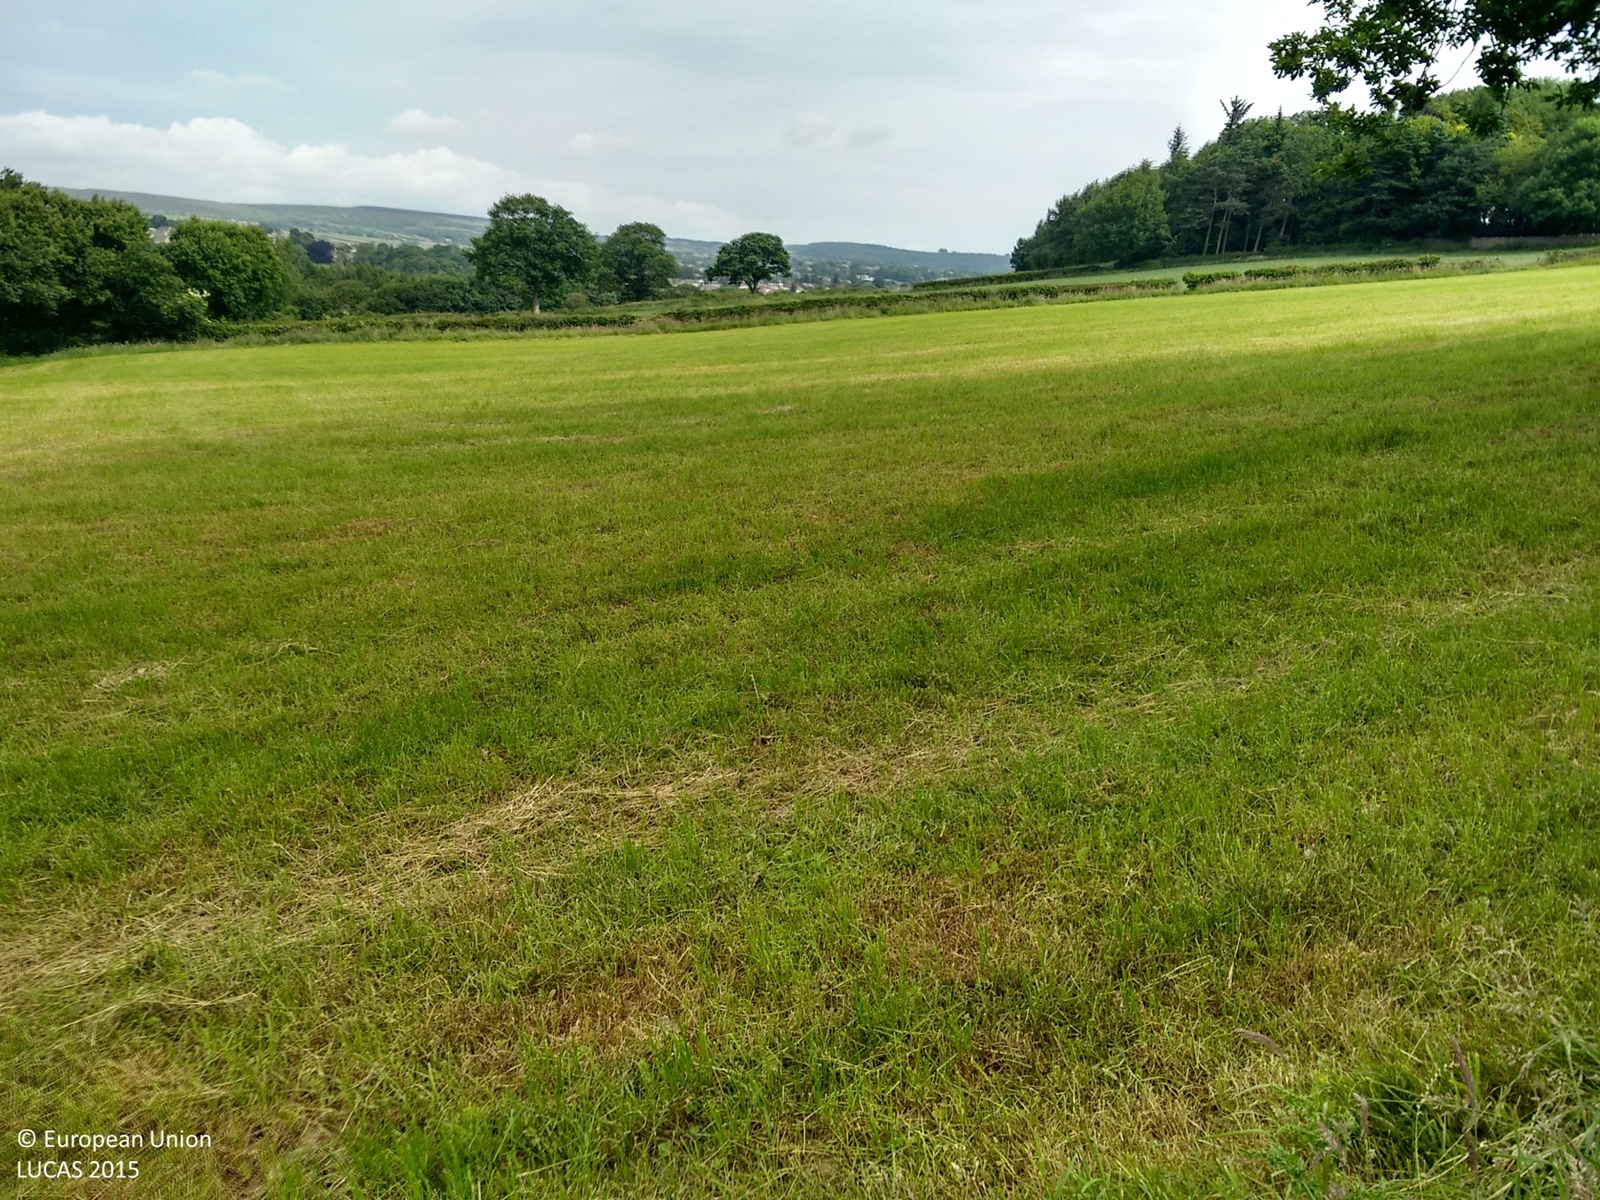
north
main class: Grassland
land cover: Grassland with sparse tree/shrub cover
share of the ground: > 75 %
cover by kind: herbaceous plants 85 %, shrubs 10 %, broadleaved forest trees 5 %
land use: Agriculture (excluding fallow land and kitchen gardens)
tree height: > 5 m
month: June
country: GB
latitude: 53.3032
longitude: -1.5303
